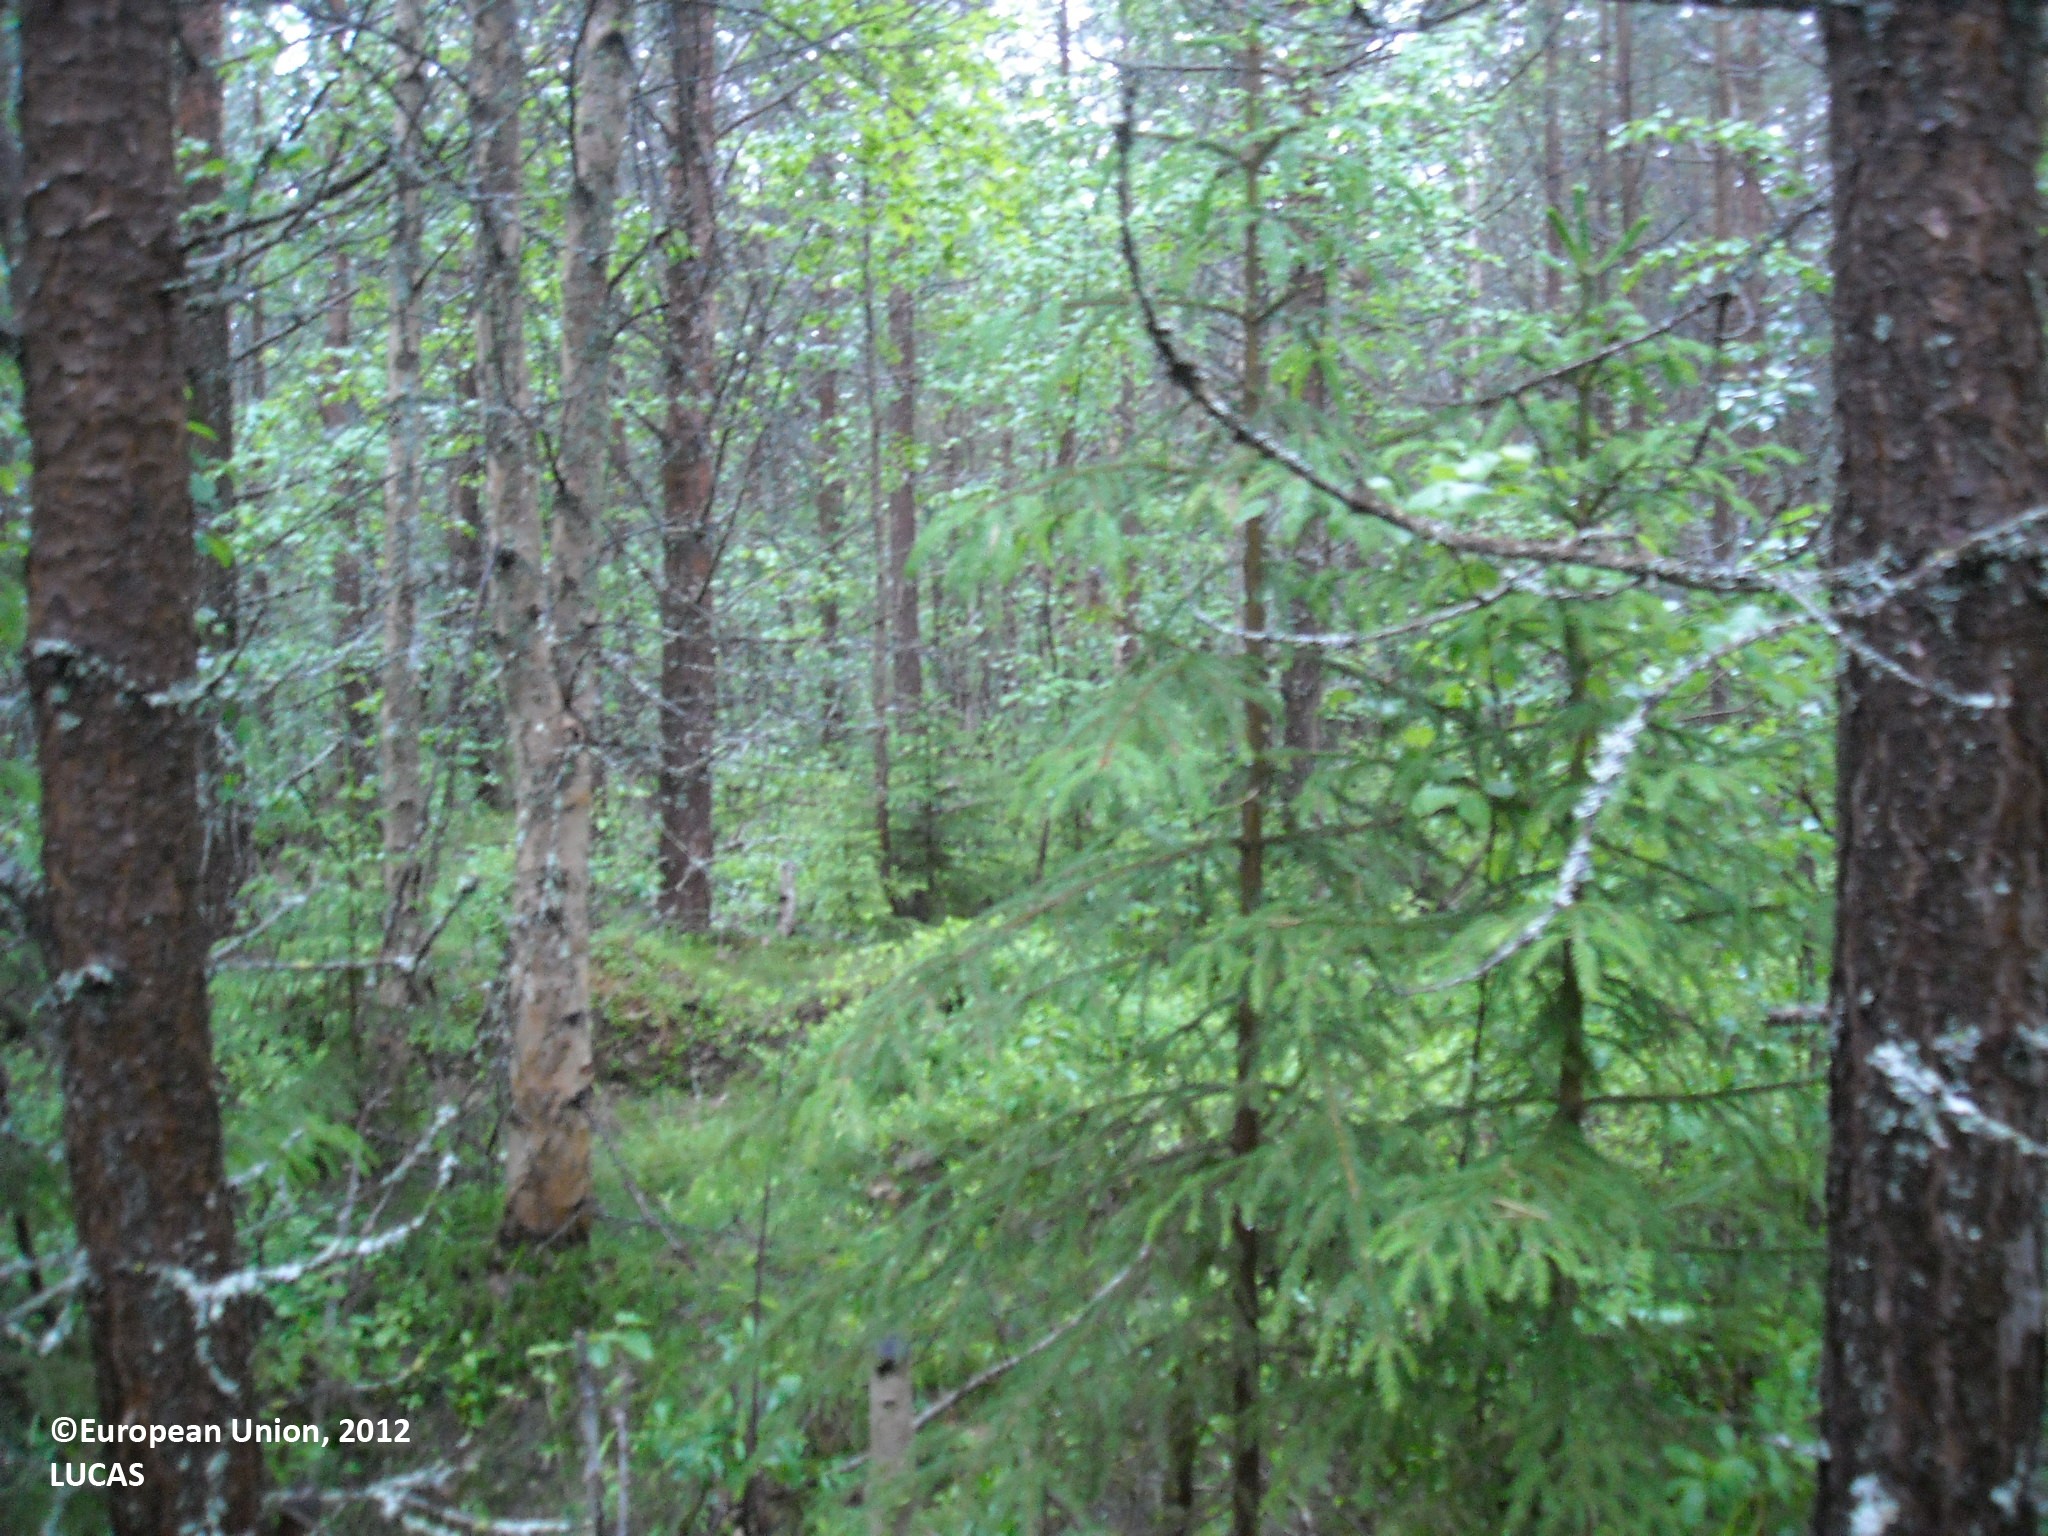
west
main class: Woodland
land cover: Pine dominated mixed woodland
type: boreal forest
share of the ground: > 75 %
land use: Forestry
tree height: > 5 m
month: July
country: FI
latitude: 65.0403
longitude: 28.1015
